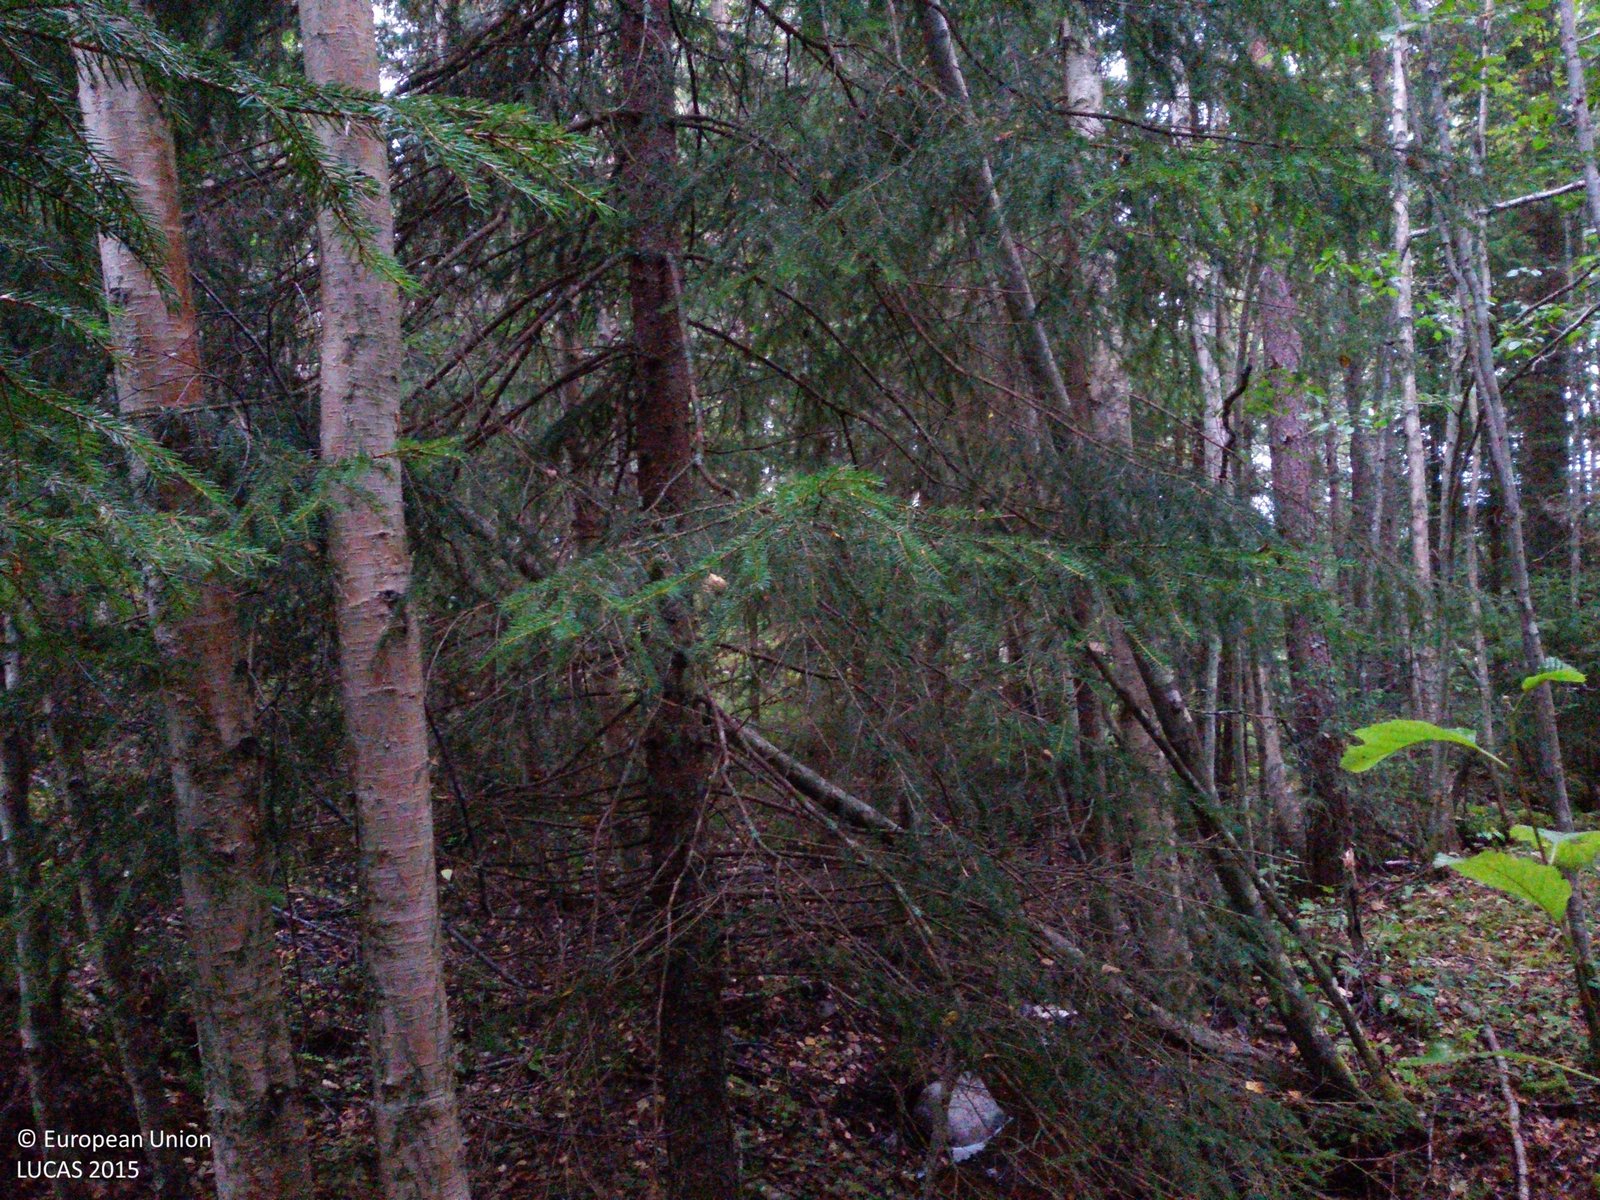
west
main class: Woodland
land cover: Spruce dominated mixed woodland
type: boreal forest
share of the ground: > 75 %
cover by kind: coniferous forest trees 55 %, broadleaved forest trees 35 %, herbaceous plants 10 %
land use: Forestry
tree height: > 5 m
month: September
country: SE
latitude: 60.7097
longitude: 14.8797
